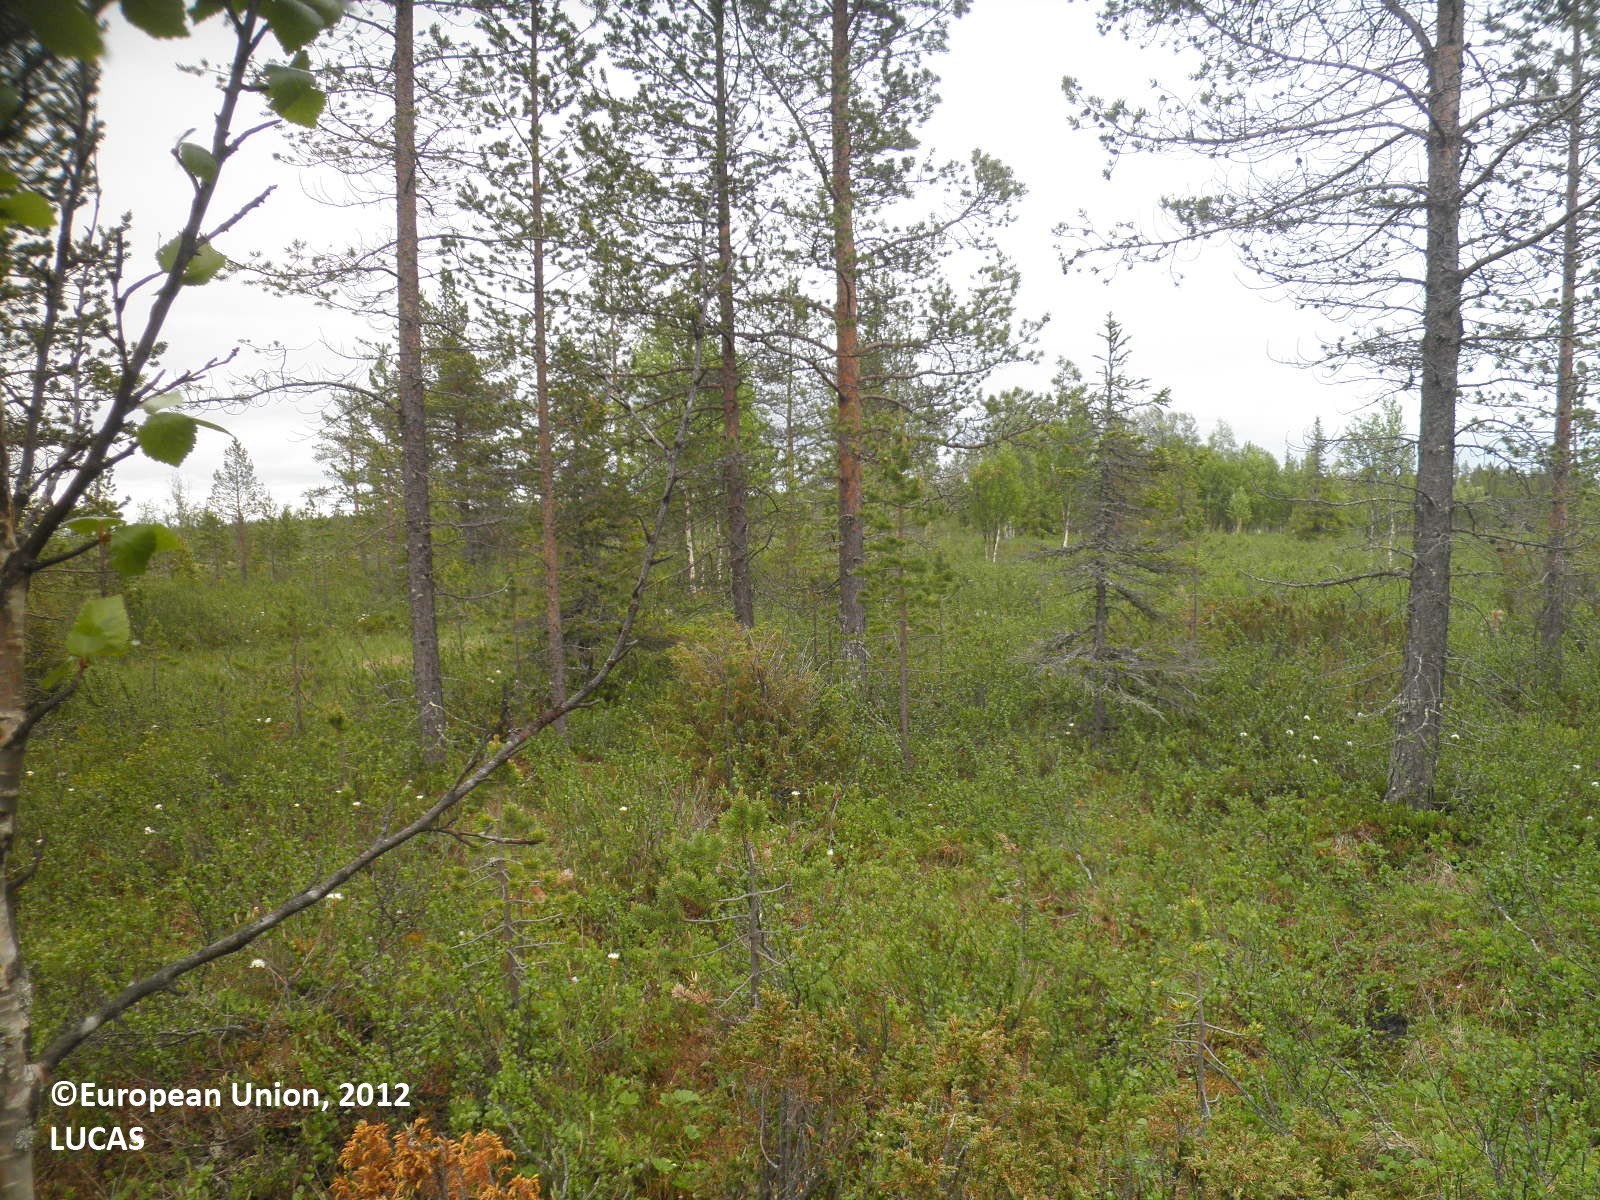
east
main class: Woodland
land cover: Pine dominated coniferous woodland
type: boreal forest
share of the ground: 25 - 50 %
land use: Forestry
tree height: > 5 m
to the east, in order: Pine dominated coniferous woodland; Shrubland with sparse tree cover; Ponds and wetlands; Shrubland with sparse tree cover; Ponds and wetlands; Shrubland with sparse tree cover; Peatbogs
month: July
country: FI
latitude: 68.3228
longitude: 25.8851
